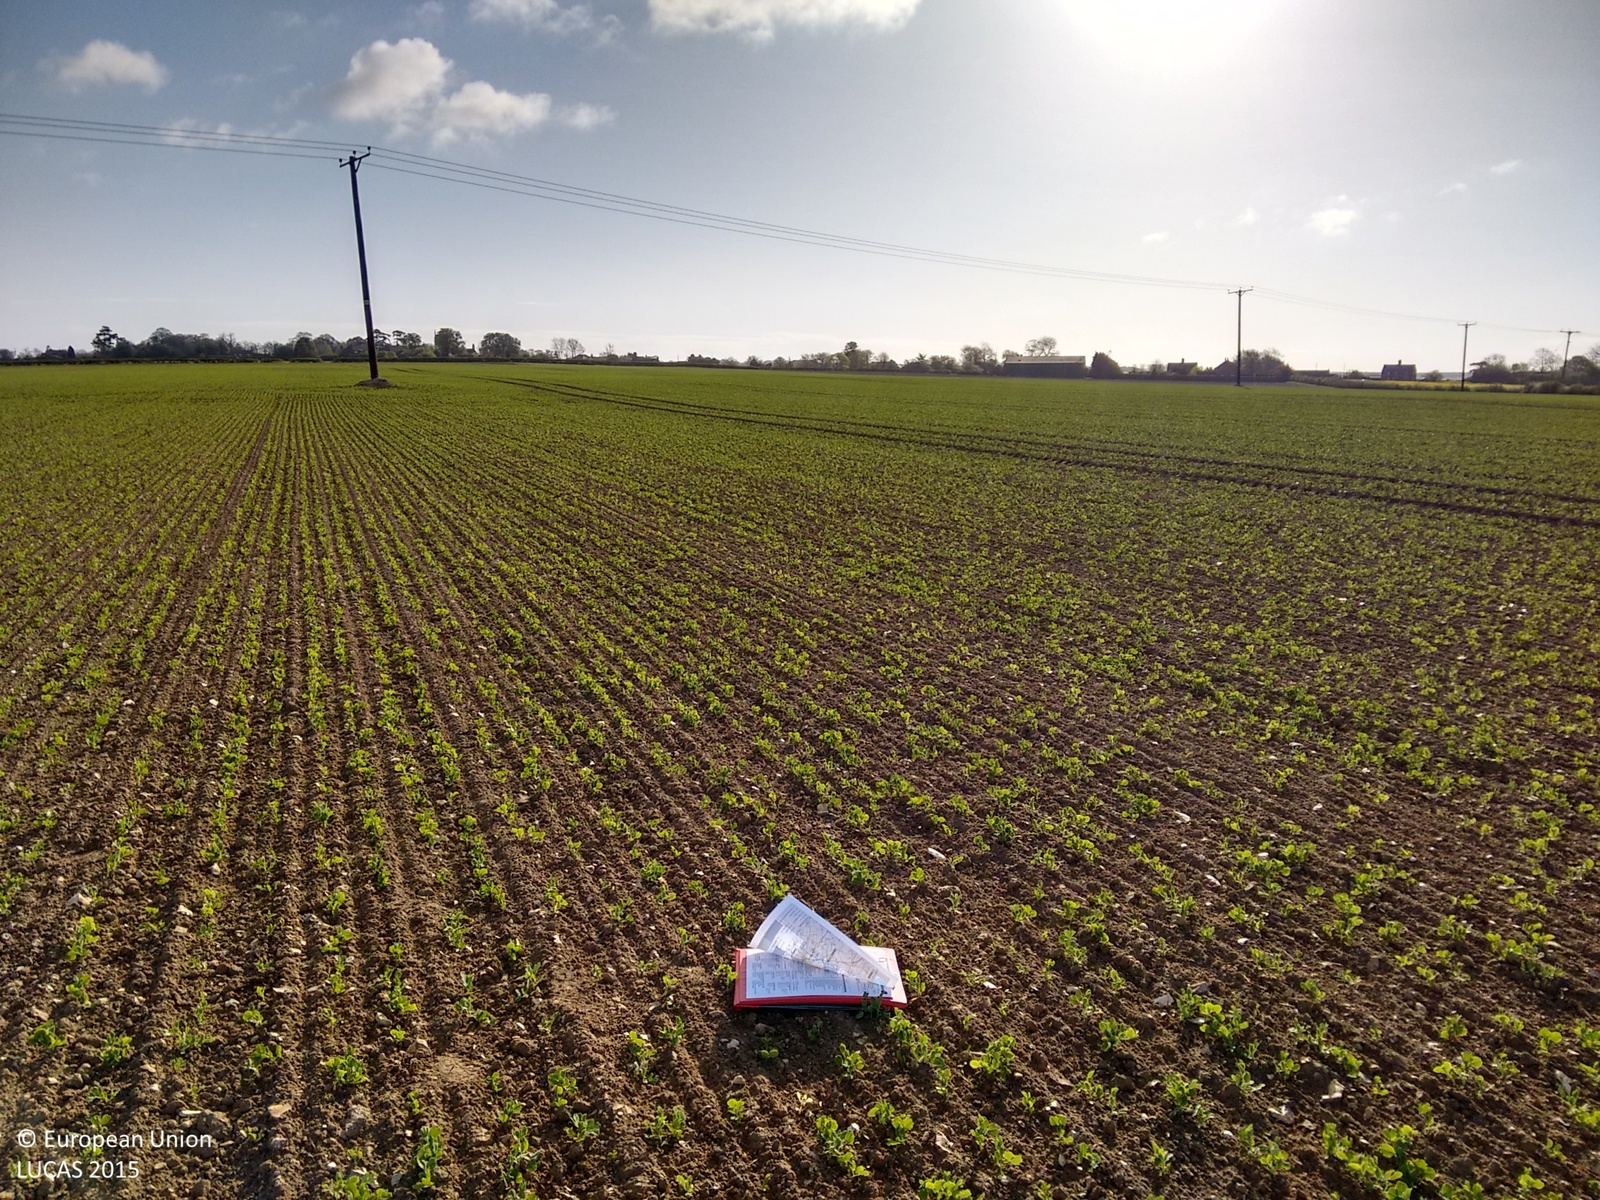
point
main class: Cropland
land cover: Dry pulses
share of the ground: < 10 %
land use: Agriculture (excluding fallow land and kitchen gardens)
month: April
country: GB
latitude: 53.2311
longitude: -0.1153
